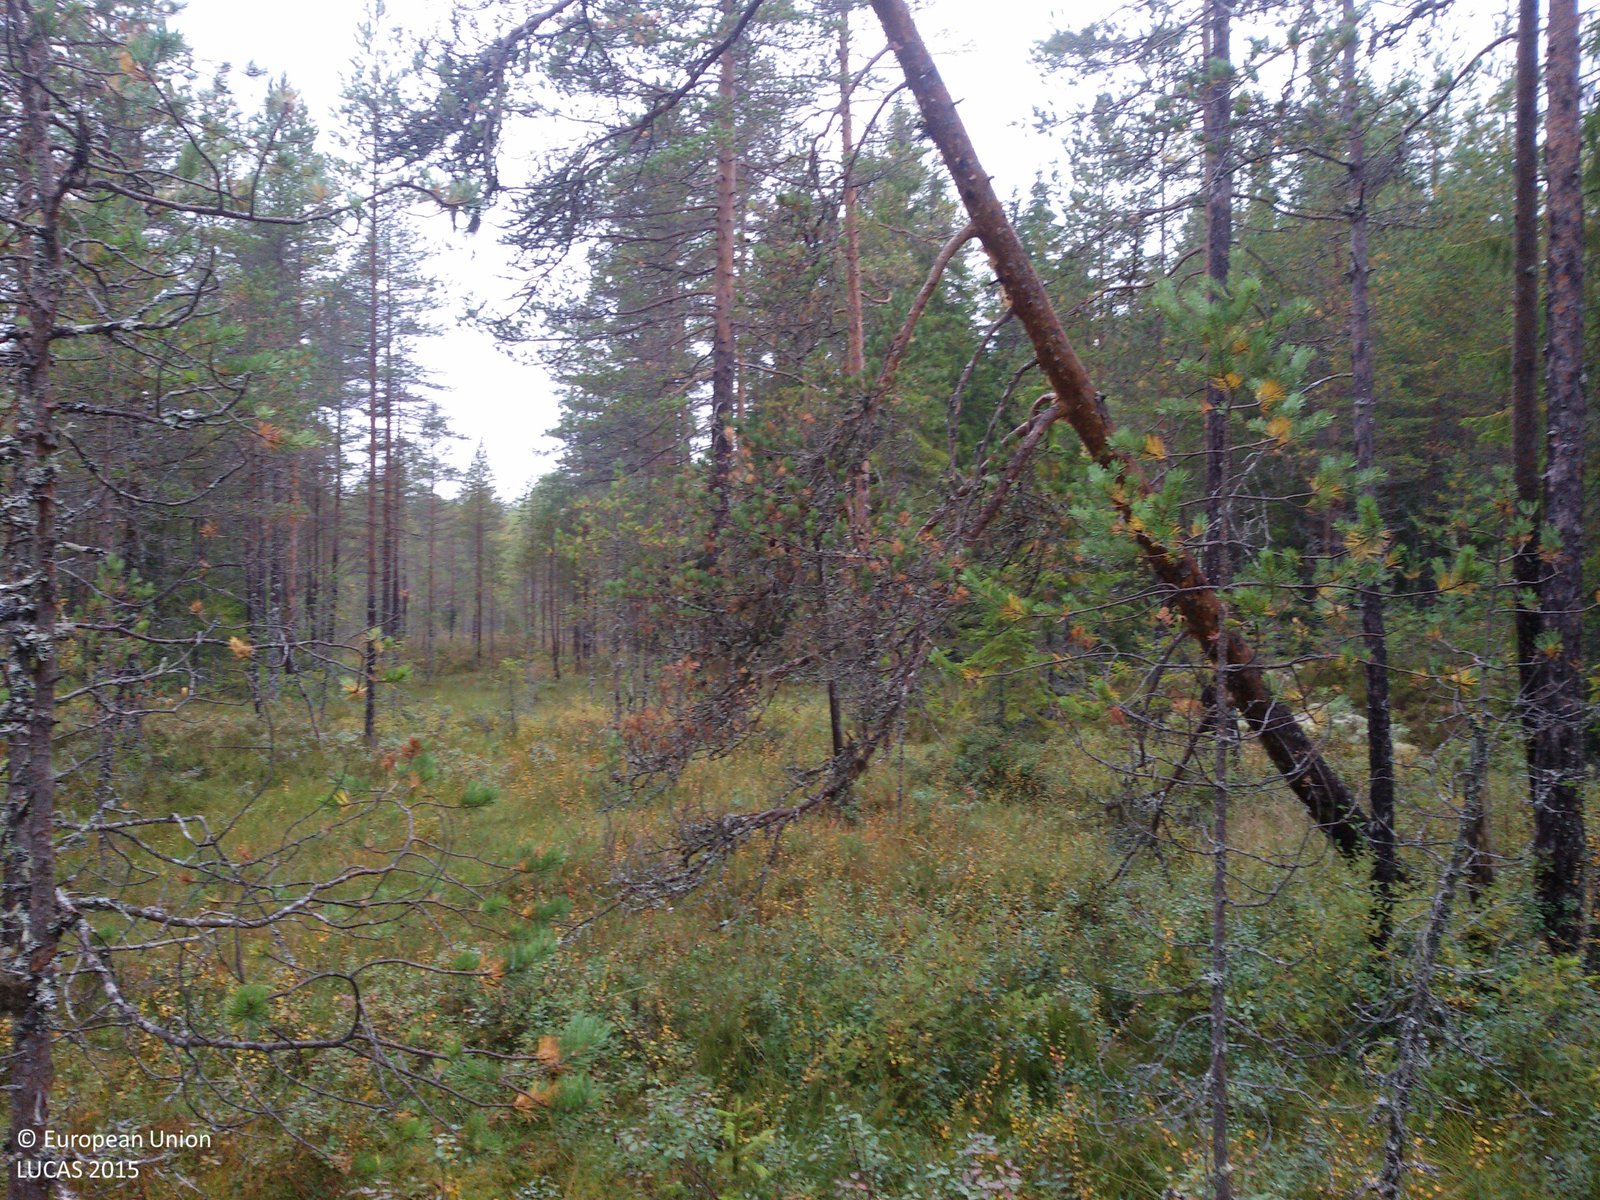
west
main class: Woodland
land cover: Pine dominated coniferous woodland
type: boreal forest
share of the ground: 50 - 75 %
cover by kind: coniferous forest trees 60 %, herbaceous plants 20 %, lichens and mosses 20 %
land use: Forestry
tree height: > 5 m
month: September
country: SE
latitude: 60.9293
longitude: 14.2123
